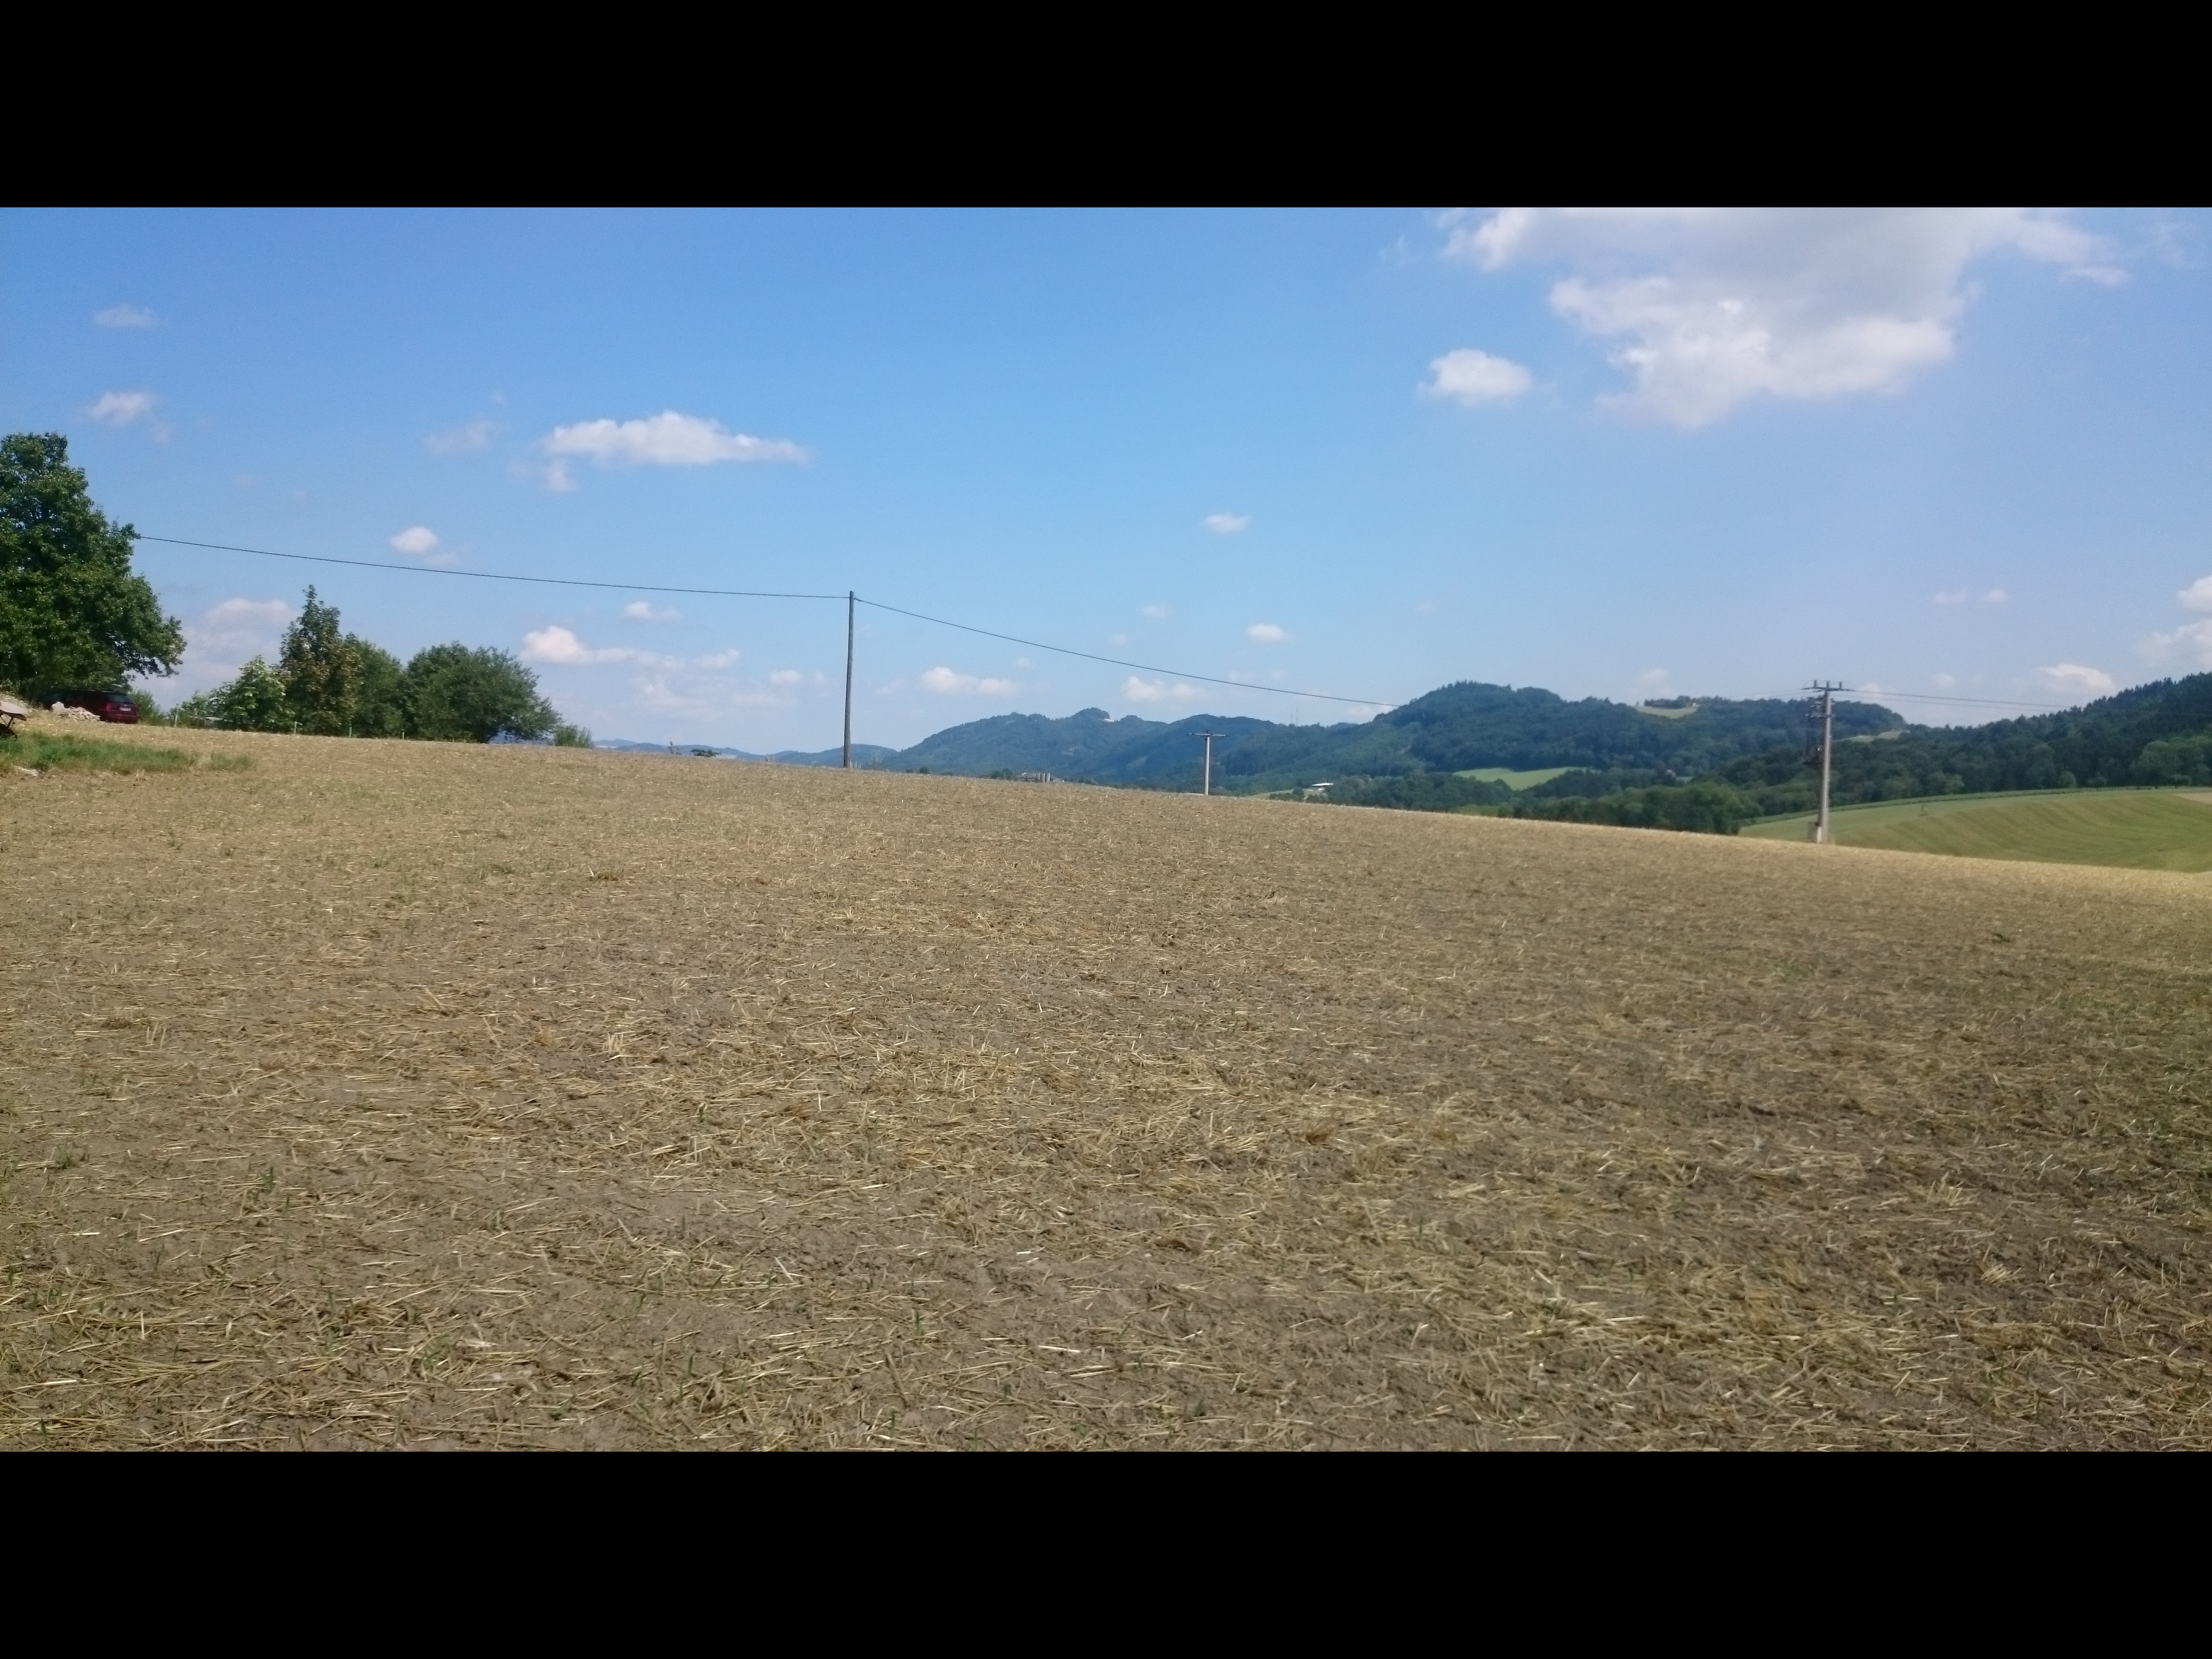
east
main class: Cropland
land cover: Barley
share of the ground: < 10 %
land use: Agriculture (excluding fallow land and kitchen gardens)
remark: Harvested field
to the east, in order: Barley; Electric lines; Barley; Paved roads, cycling and walking lanes; Grassland without tree/shrub cover; Apple fruit; Grassland without tree/shrub cover; Barley; Electric lines
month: July
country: AT
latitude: 48.2269
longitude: 14.8066
